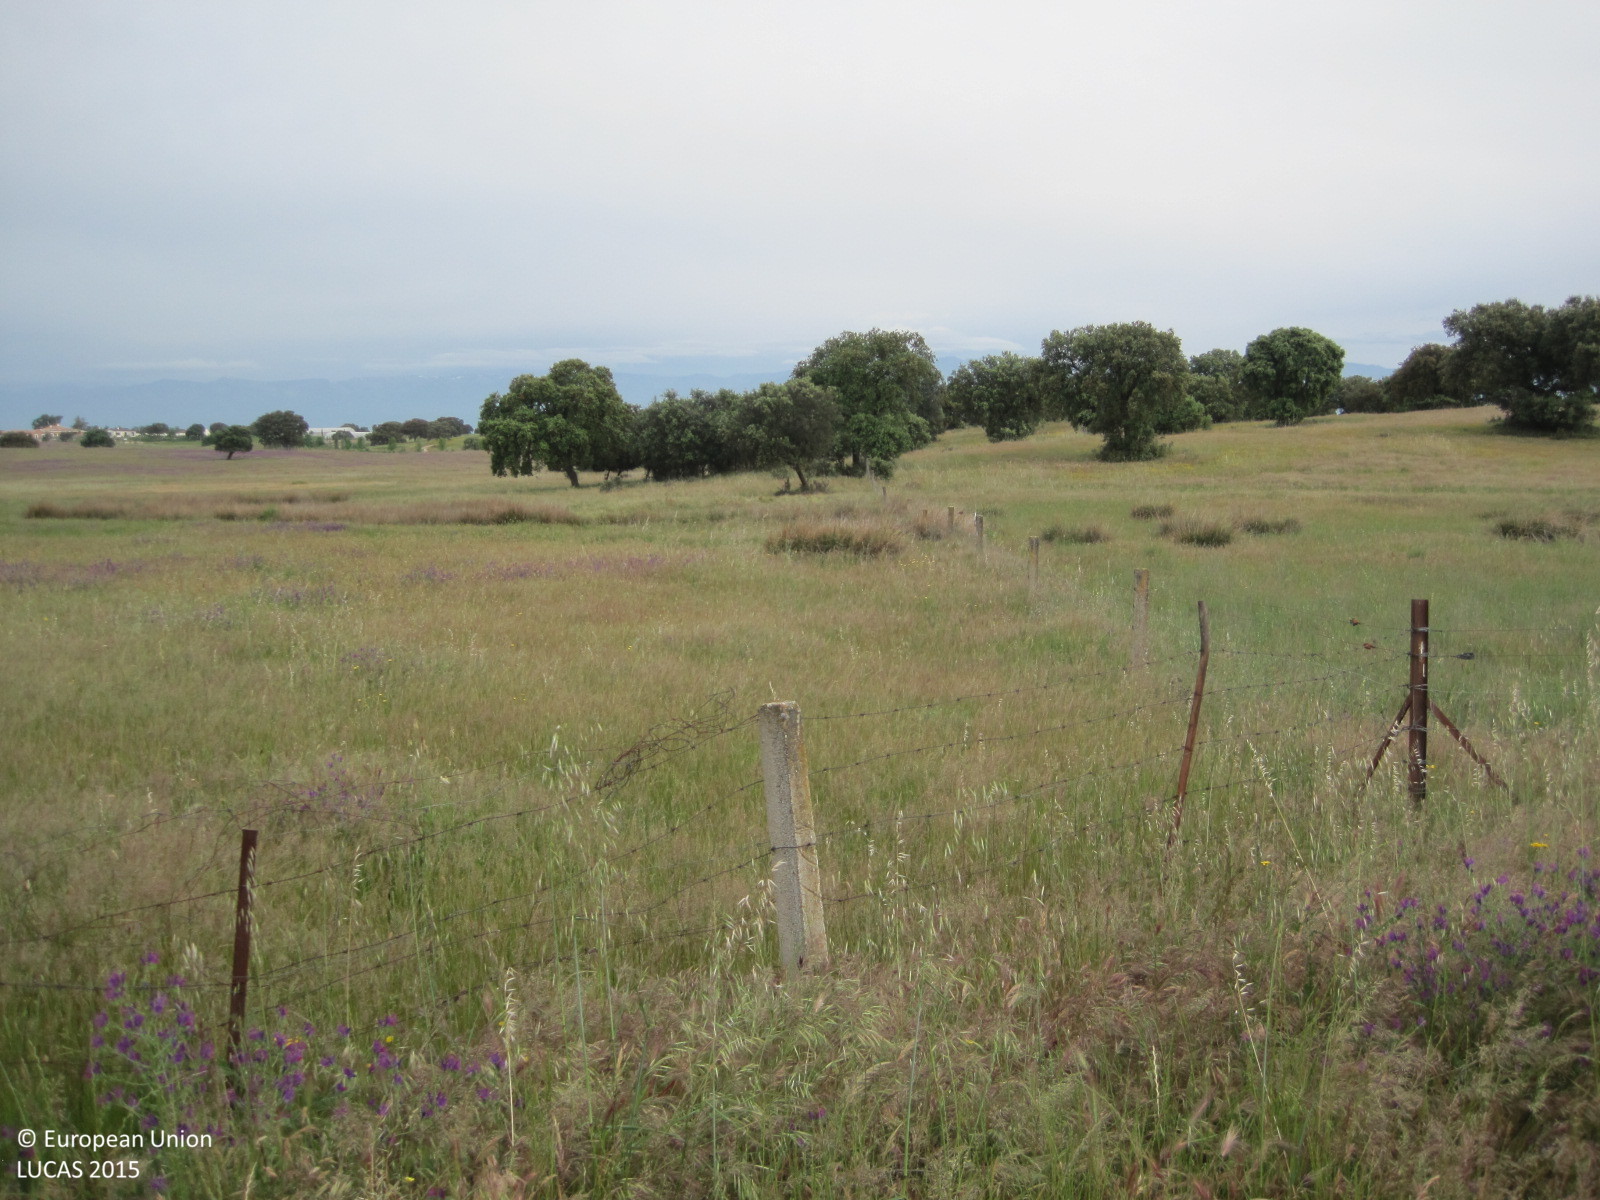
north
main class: Cropland
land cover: Arable land (only in case pi)
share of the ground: > 75 %
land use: Agriculture (excluding fallow land and kitchen gardens)
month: May
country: ES
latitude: 39.8951
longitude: -5.1270
